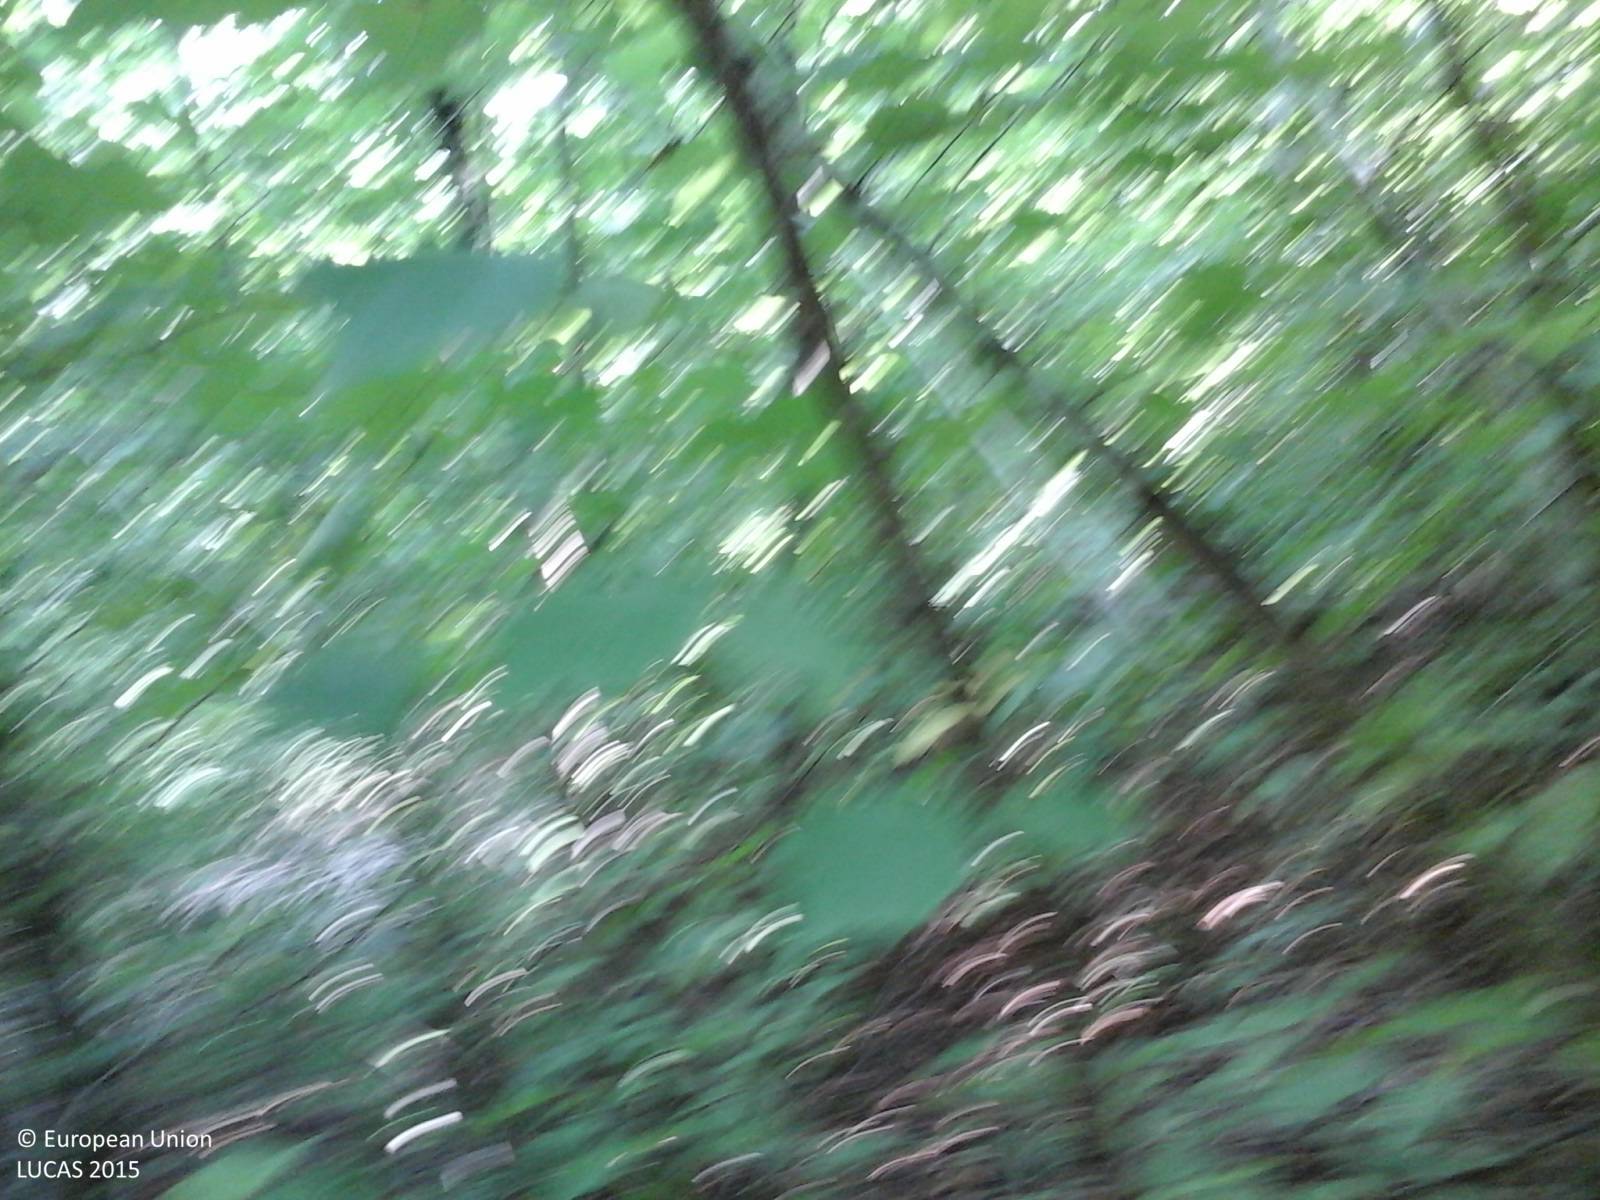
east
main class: Woodland
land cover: Broadleaved woodland
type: thermophilous deciduous forest
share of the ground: > 75 %
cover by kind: broadleaved forest trees 100 %
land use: Forestry
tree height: > 5 m
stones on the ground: < 10 %
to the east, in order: Broadleaved woodland; Tracks; Electric lines; Broadleaved woodland; Nuts trees; Electric lines; Nuts trees; Grass margins; Paved roads, cycling and walking lanes; Fences; Shrubland with sparse tree cover; Broadleaved woodland
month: August
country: IT
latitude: 42.2324
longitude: 12.2096
